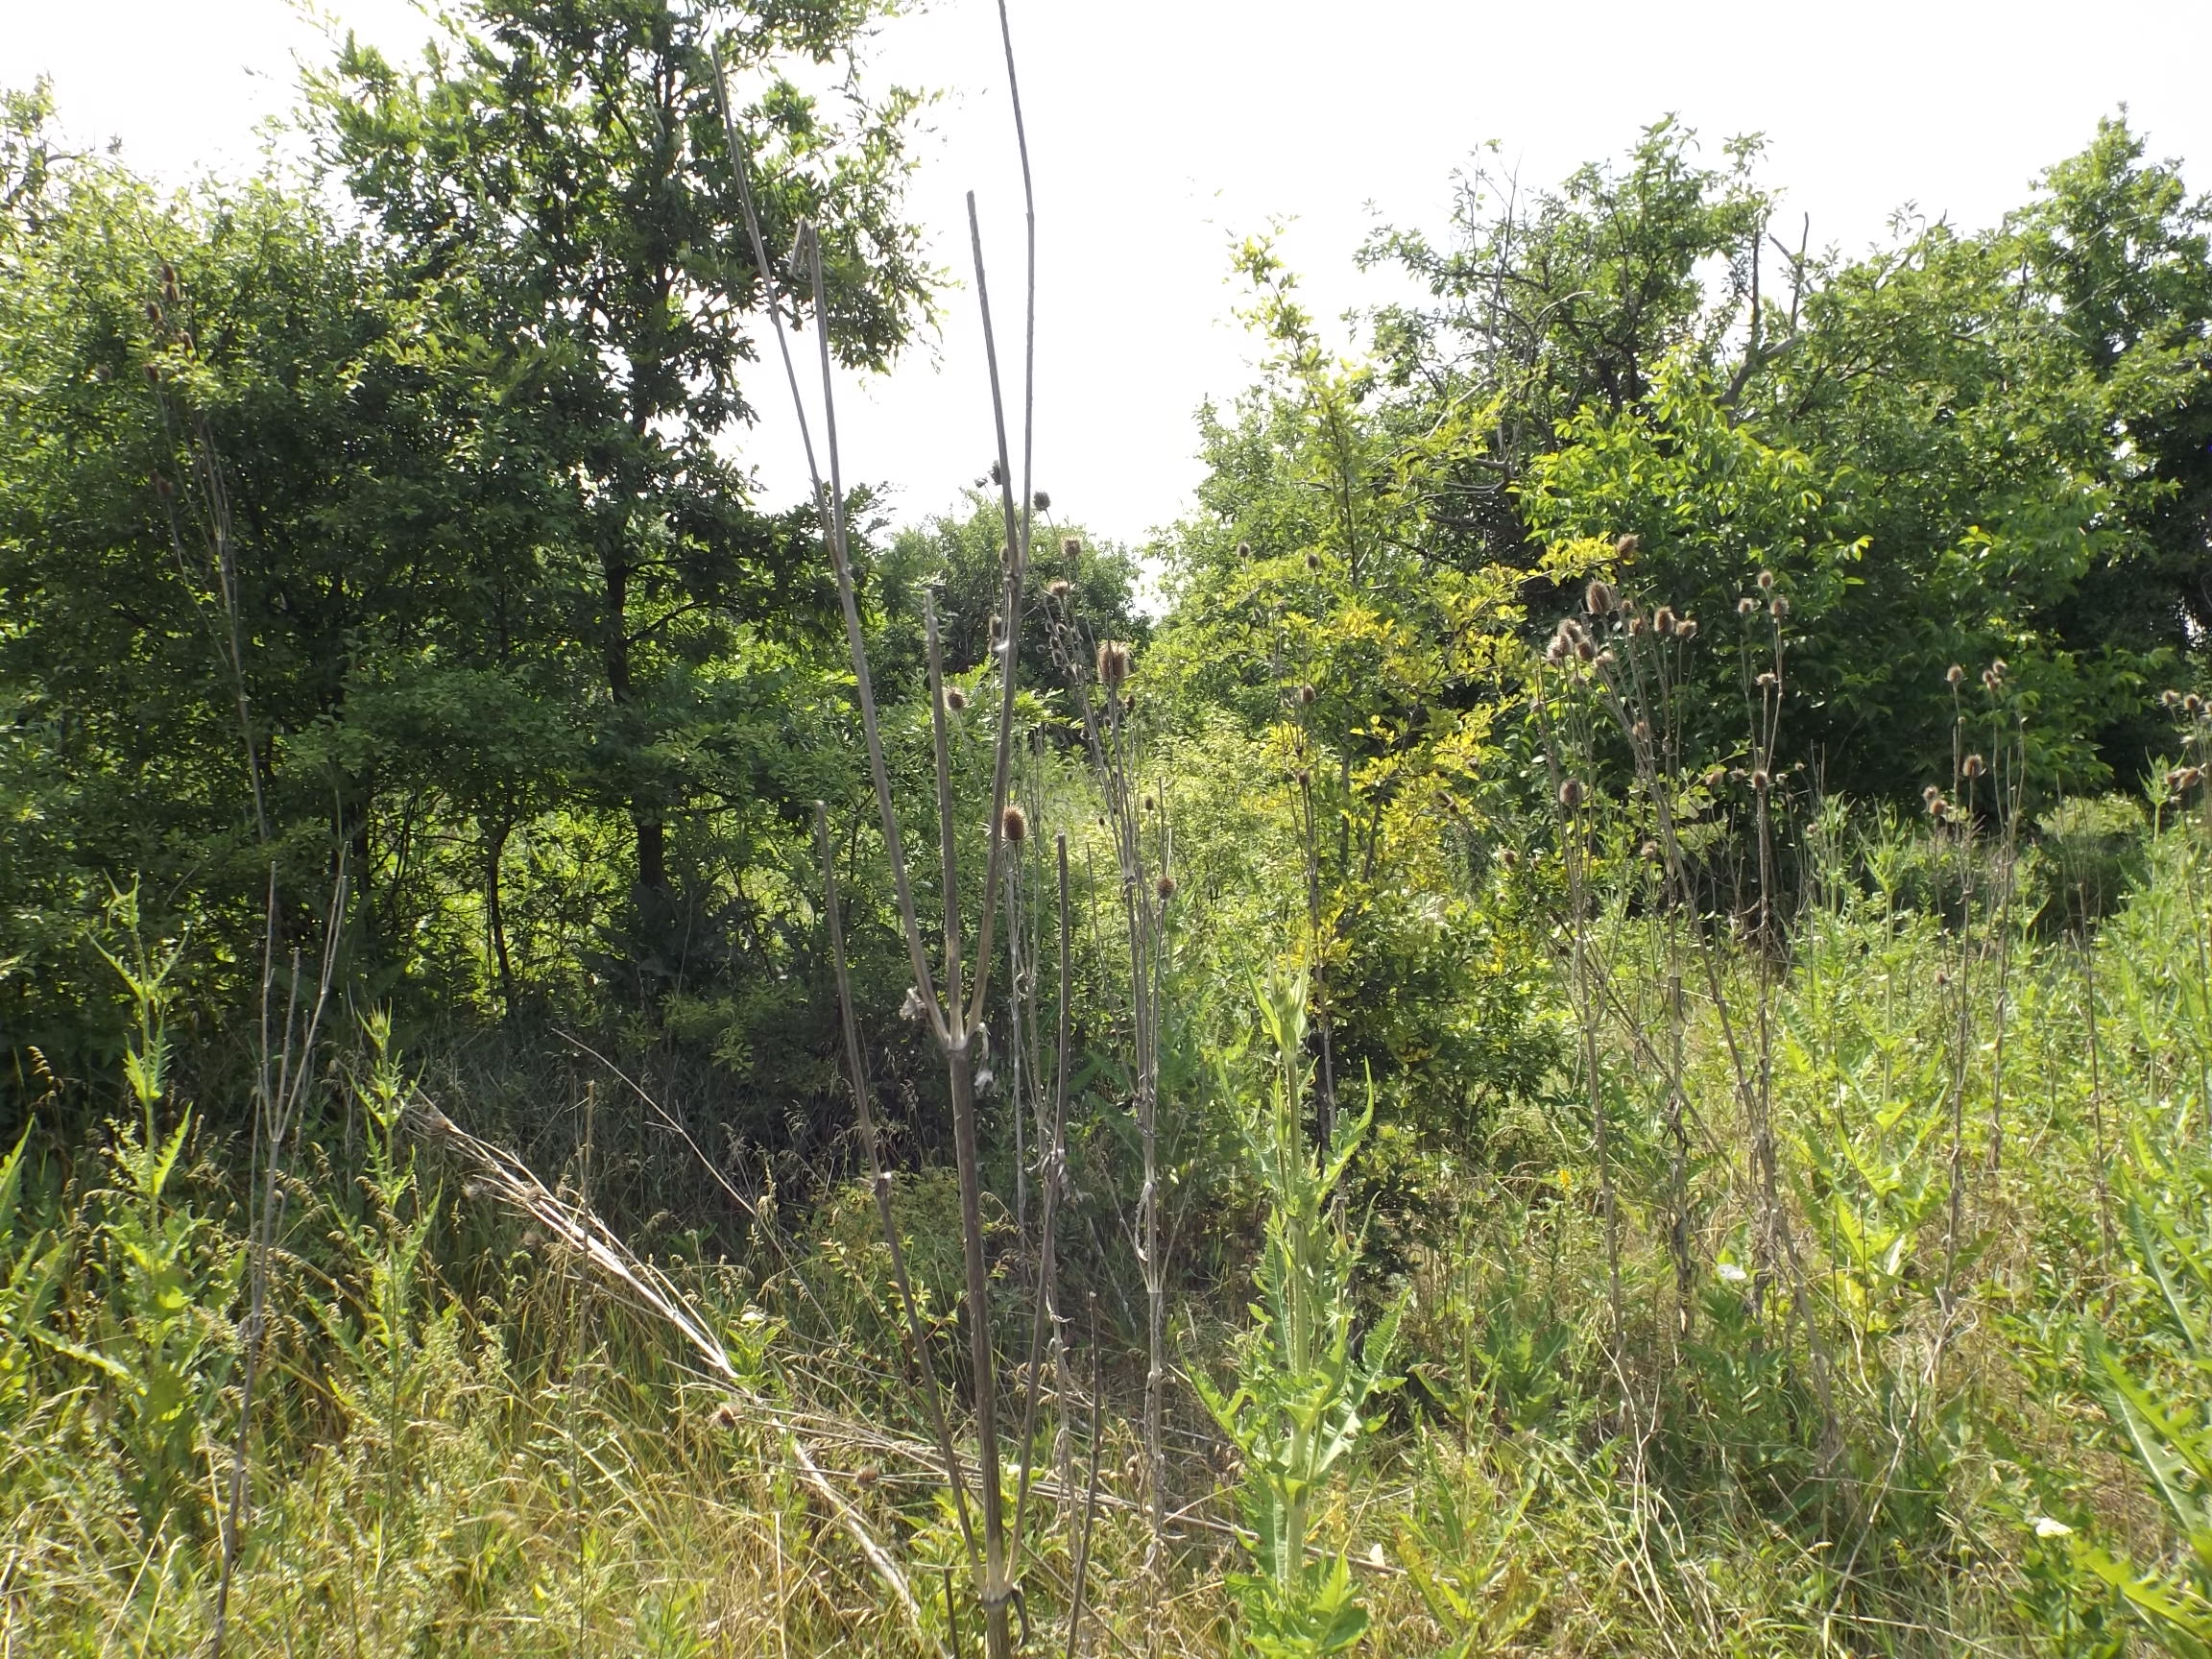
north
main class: Cropland
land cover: Apple fruit
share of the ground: 25 - 50 %
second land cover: Spontaneously vegetated surfaces
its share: > 75 %
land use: Agriculture (excluding fallow land and kitchen gardens)
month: June
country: BG
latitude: 43.5315
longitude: 27.3899
